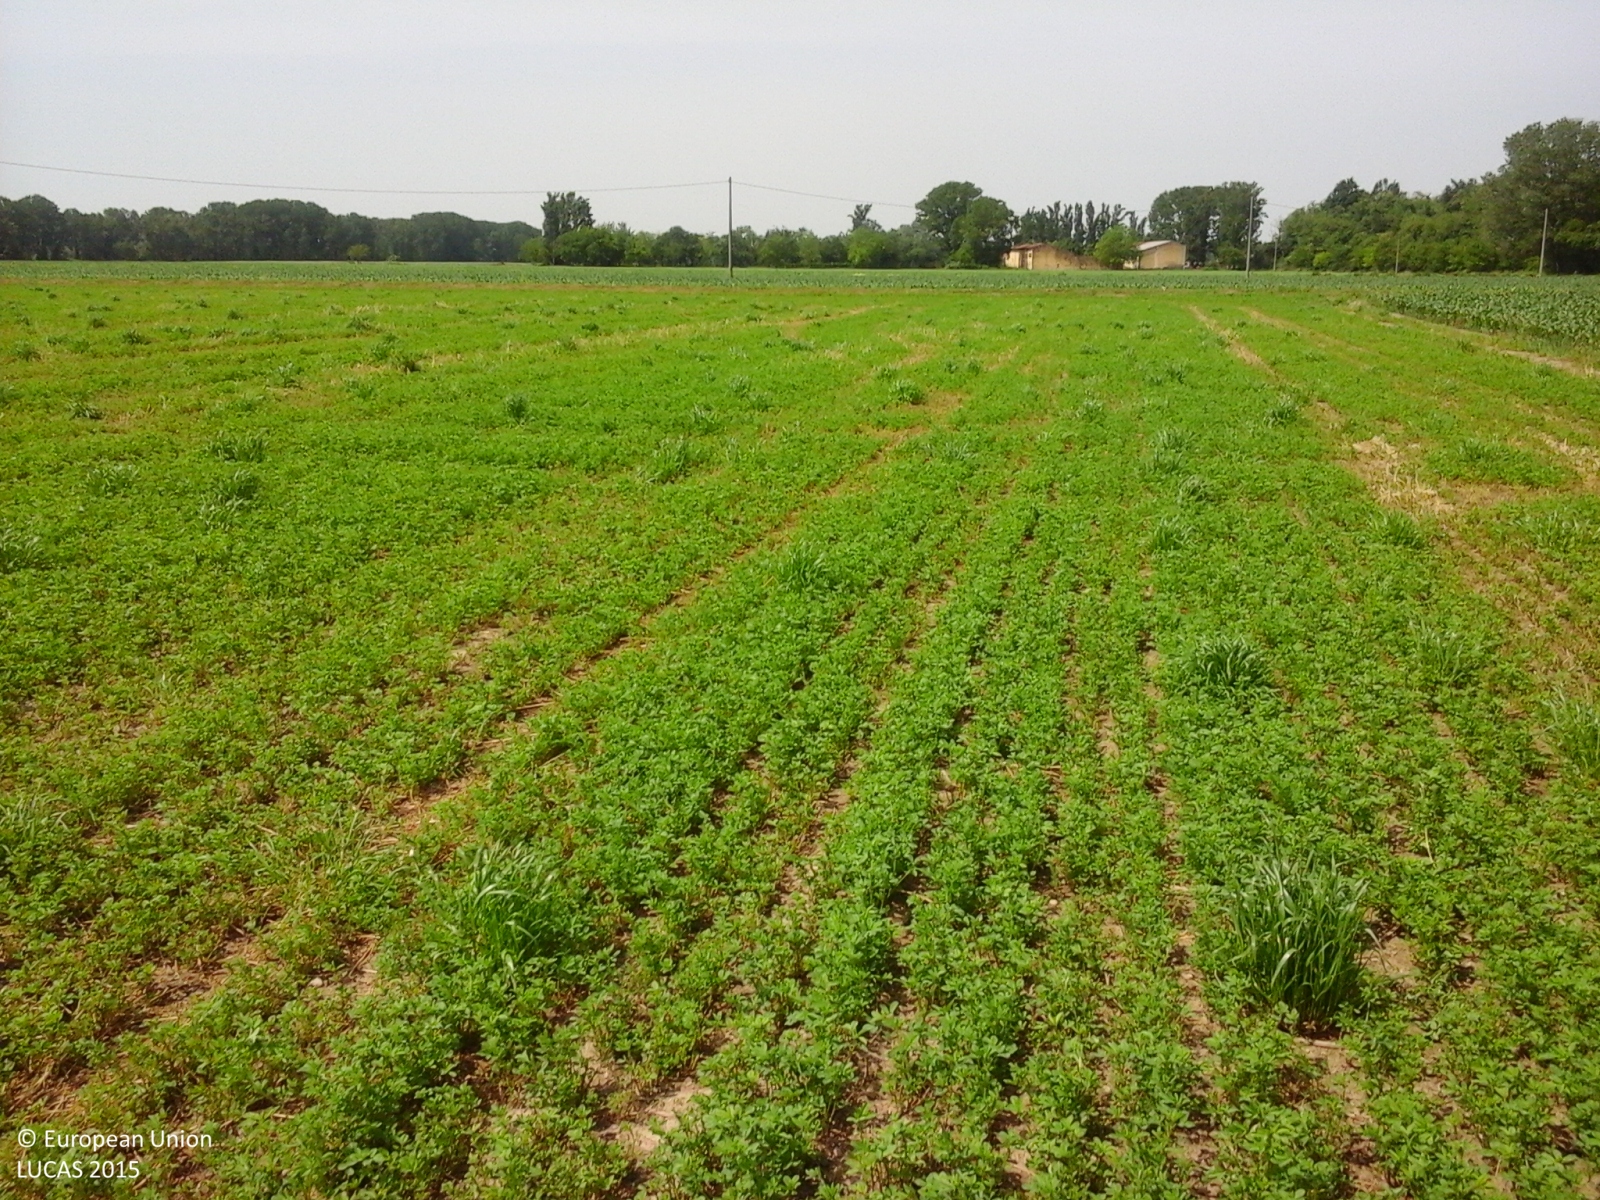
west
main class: Cropland
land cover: Lucerne
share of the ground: > 75 %
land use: Agriculture (excluding fallow land and kitchen gardens)
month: May
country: IT
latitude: 45.3421
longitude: 9.9108
